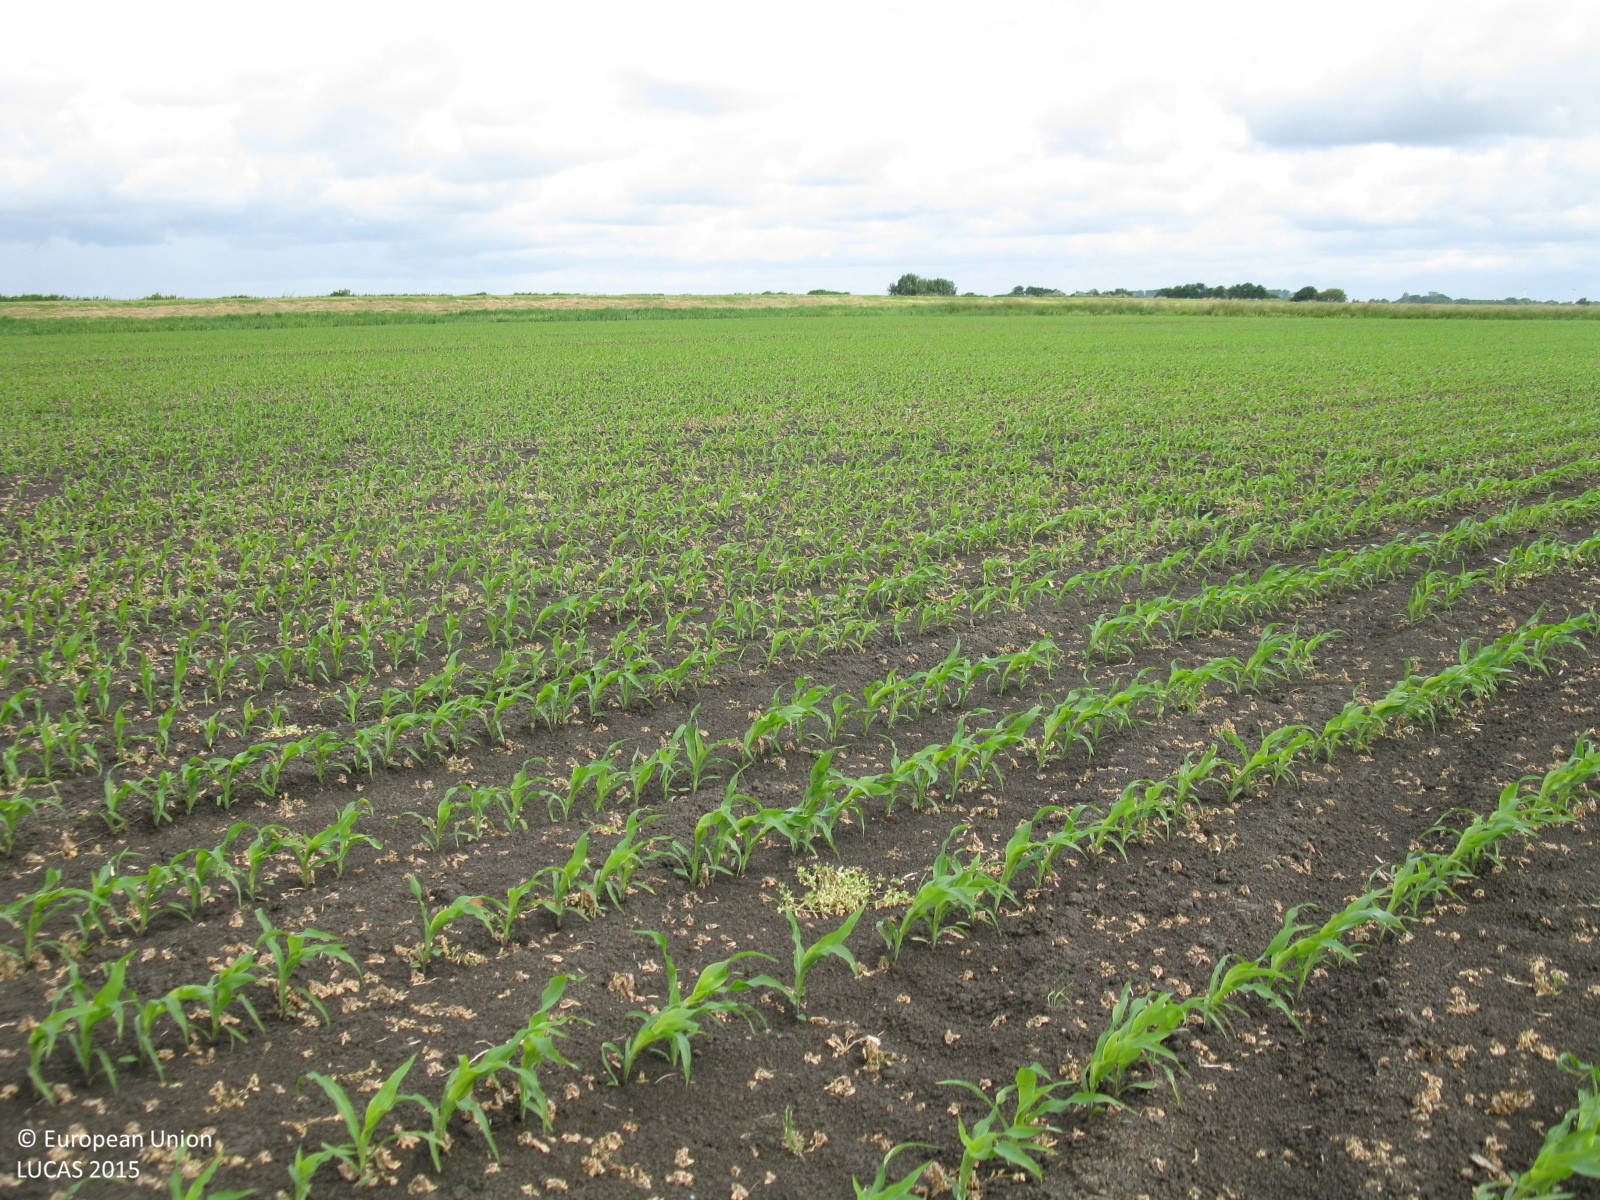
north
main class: Cropland
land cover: Maize
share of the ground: 10 - 25 %
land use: Agriculture (excluding fallow land and kitchen gardens)
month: June
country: DE
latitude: 53.4087
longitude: 7.3380
